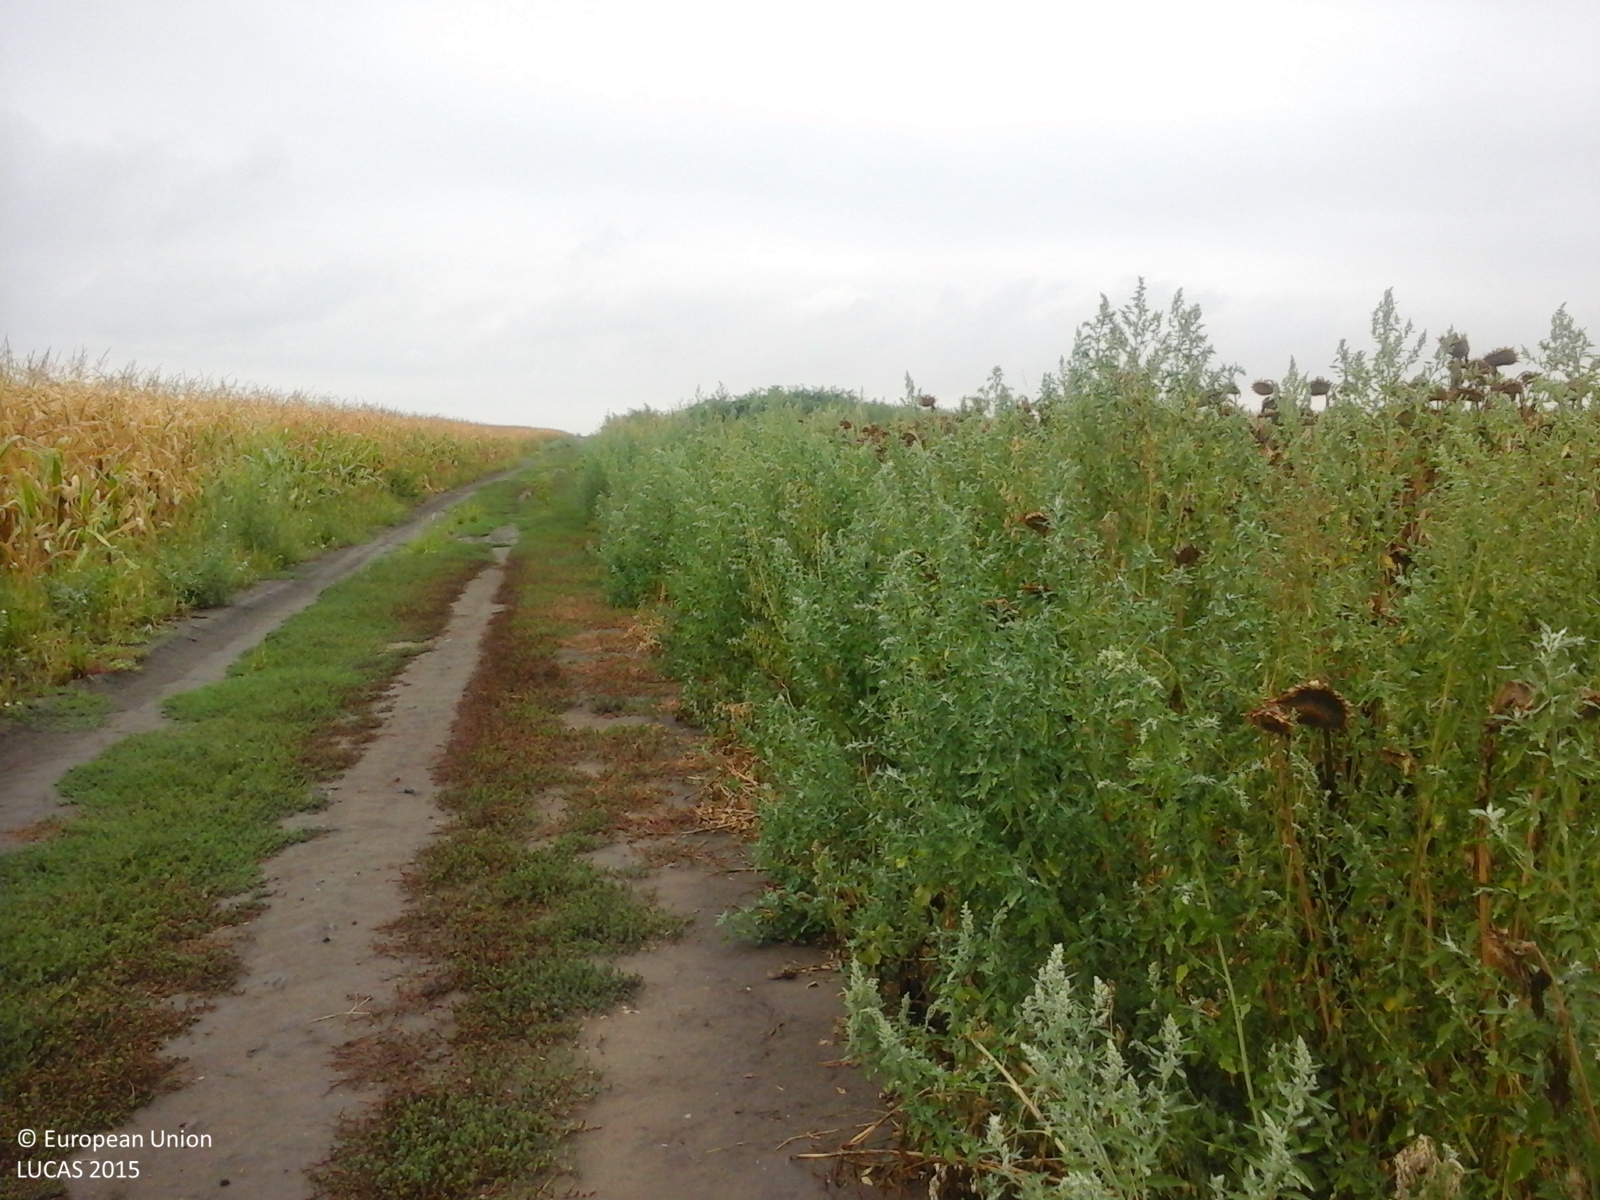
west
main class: Cropland
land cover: Sunflower
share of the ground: > 75 %
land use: Agriculture (excluding fallow land and kitchen gardens)
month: August
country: RO
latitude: 45.9738
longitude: 20.7256
